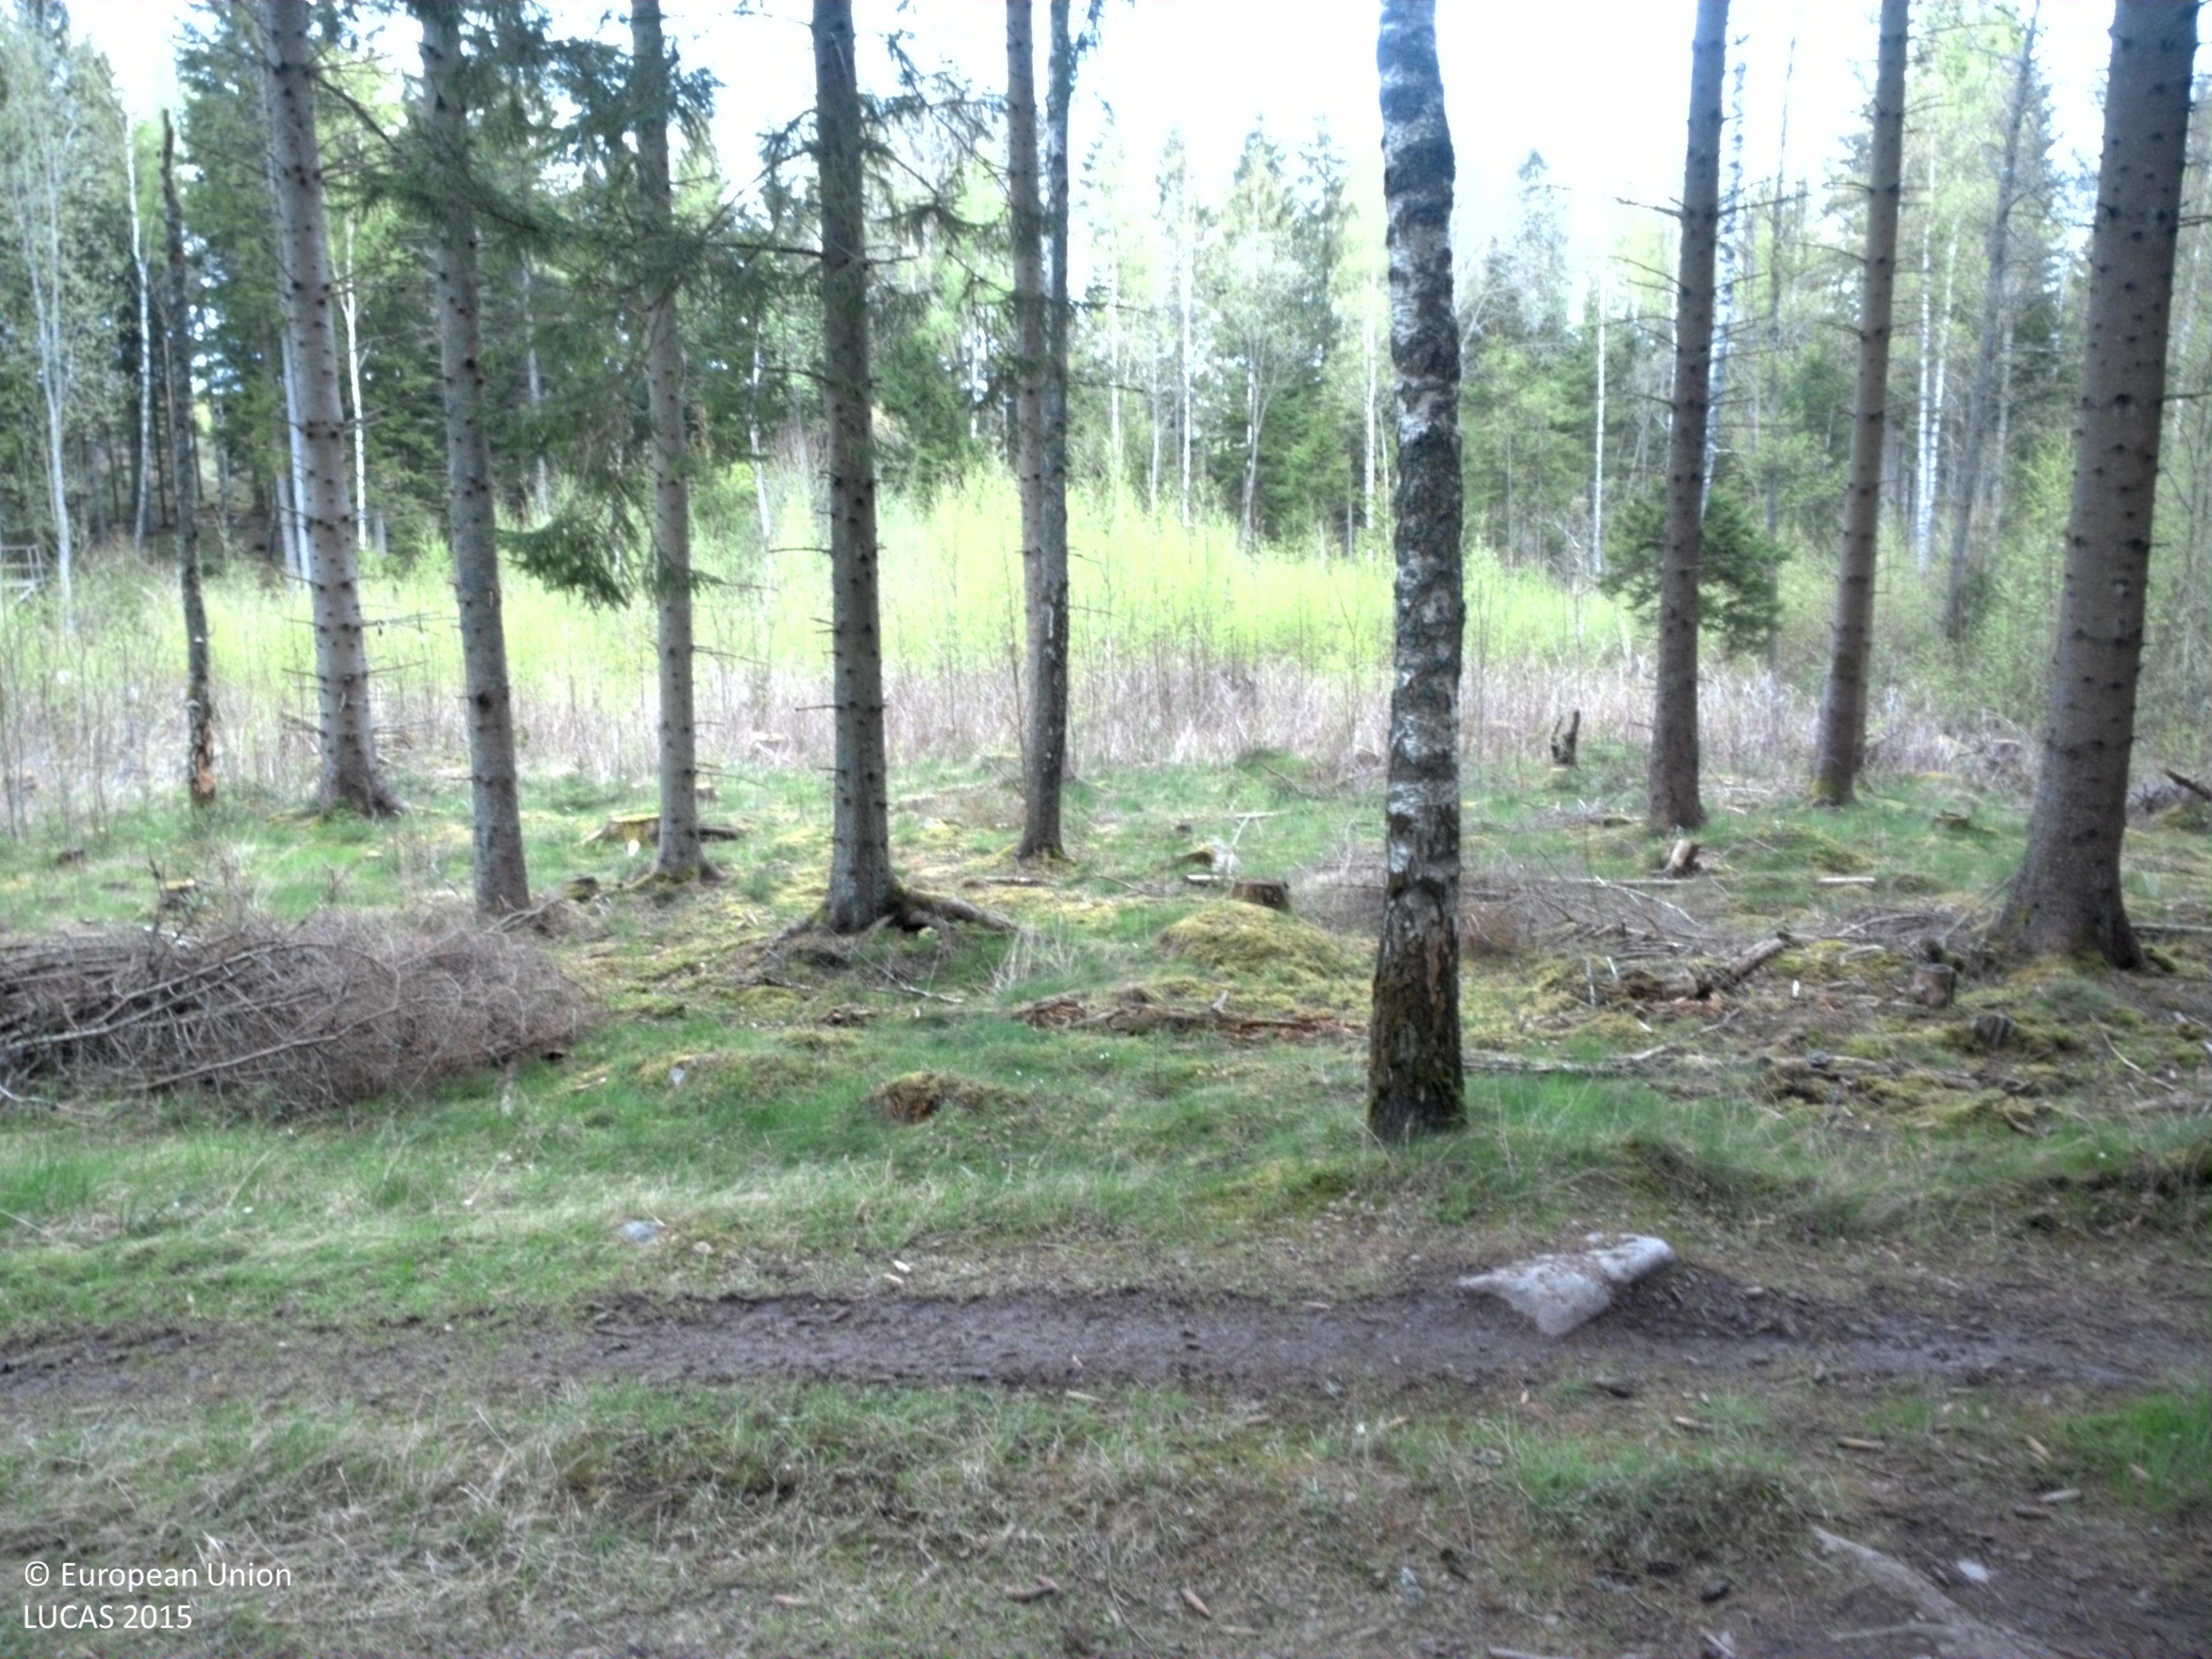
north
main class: Woodland
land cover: Spruce dominated coniferous woodland
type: boreal forest
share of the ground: > 75 %
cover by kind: coniferous forest trees 80 %, lichens and mosses 20 %
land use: Forestry
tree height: > 5 m
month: May
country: SE
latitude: 56.8378
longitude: 14.7671
